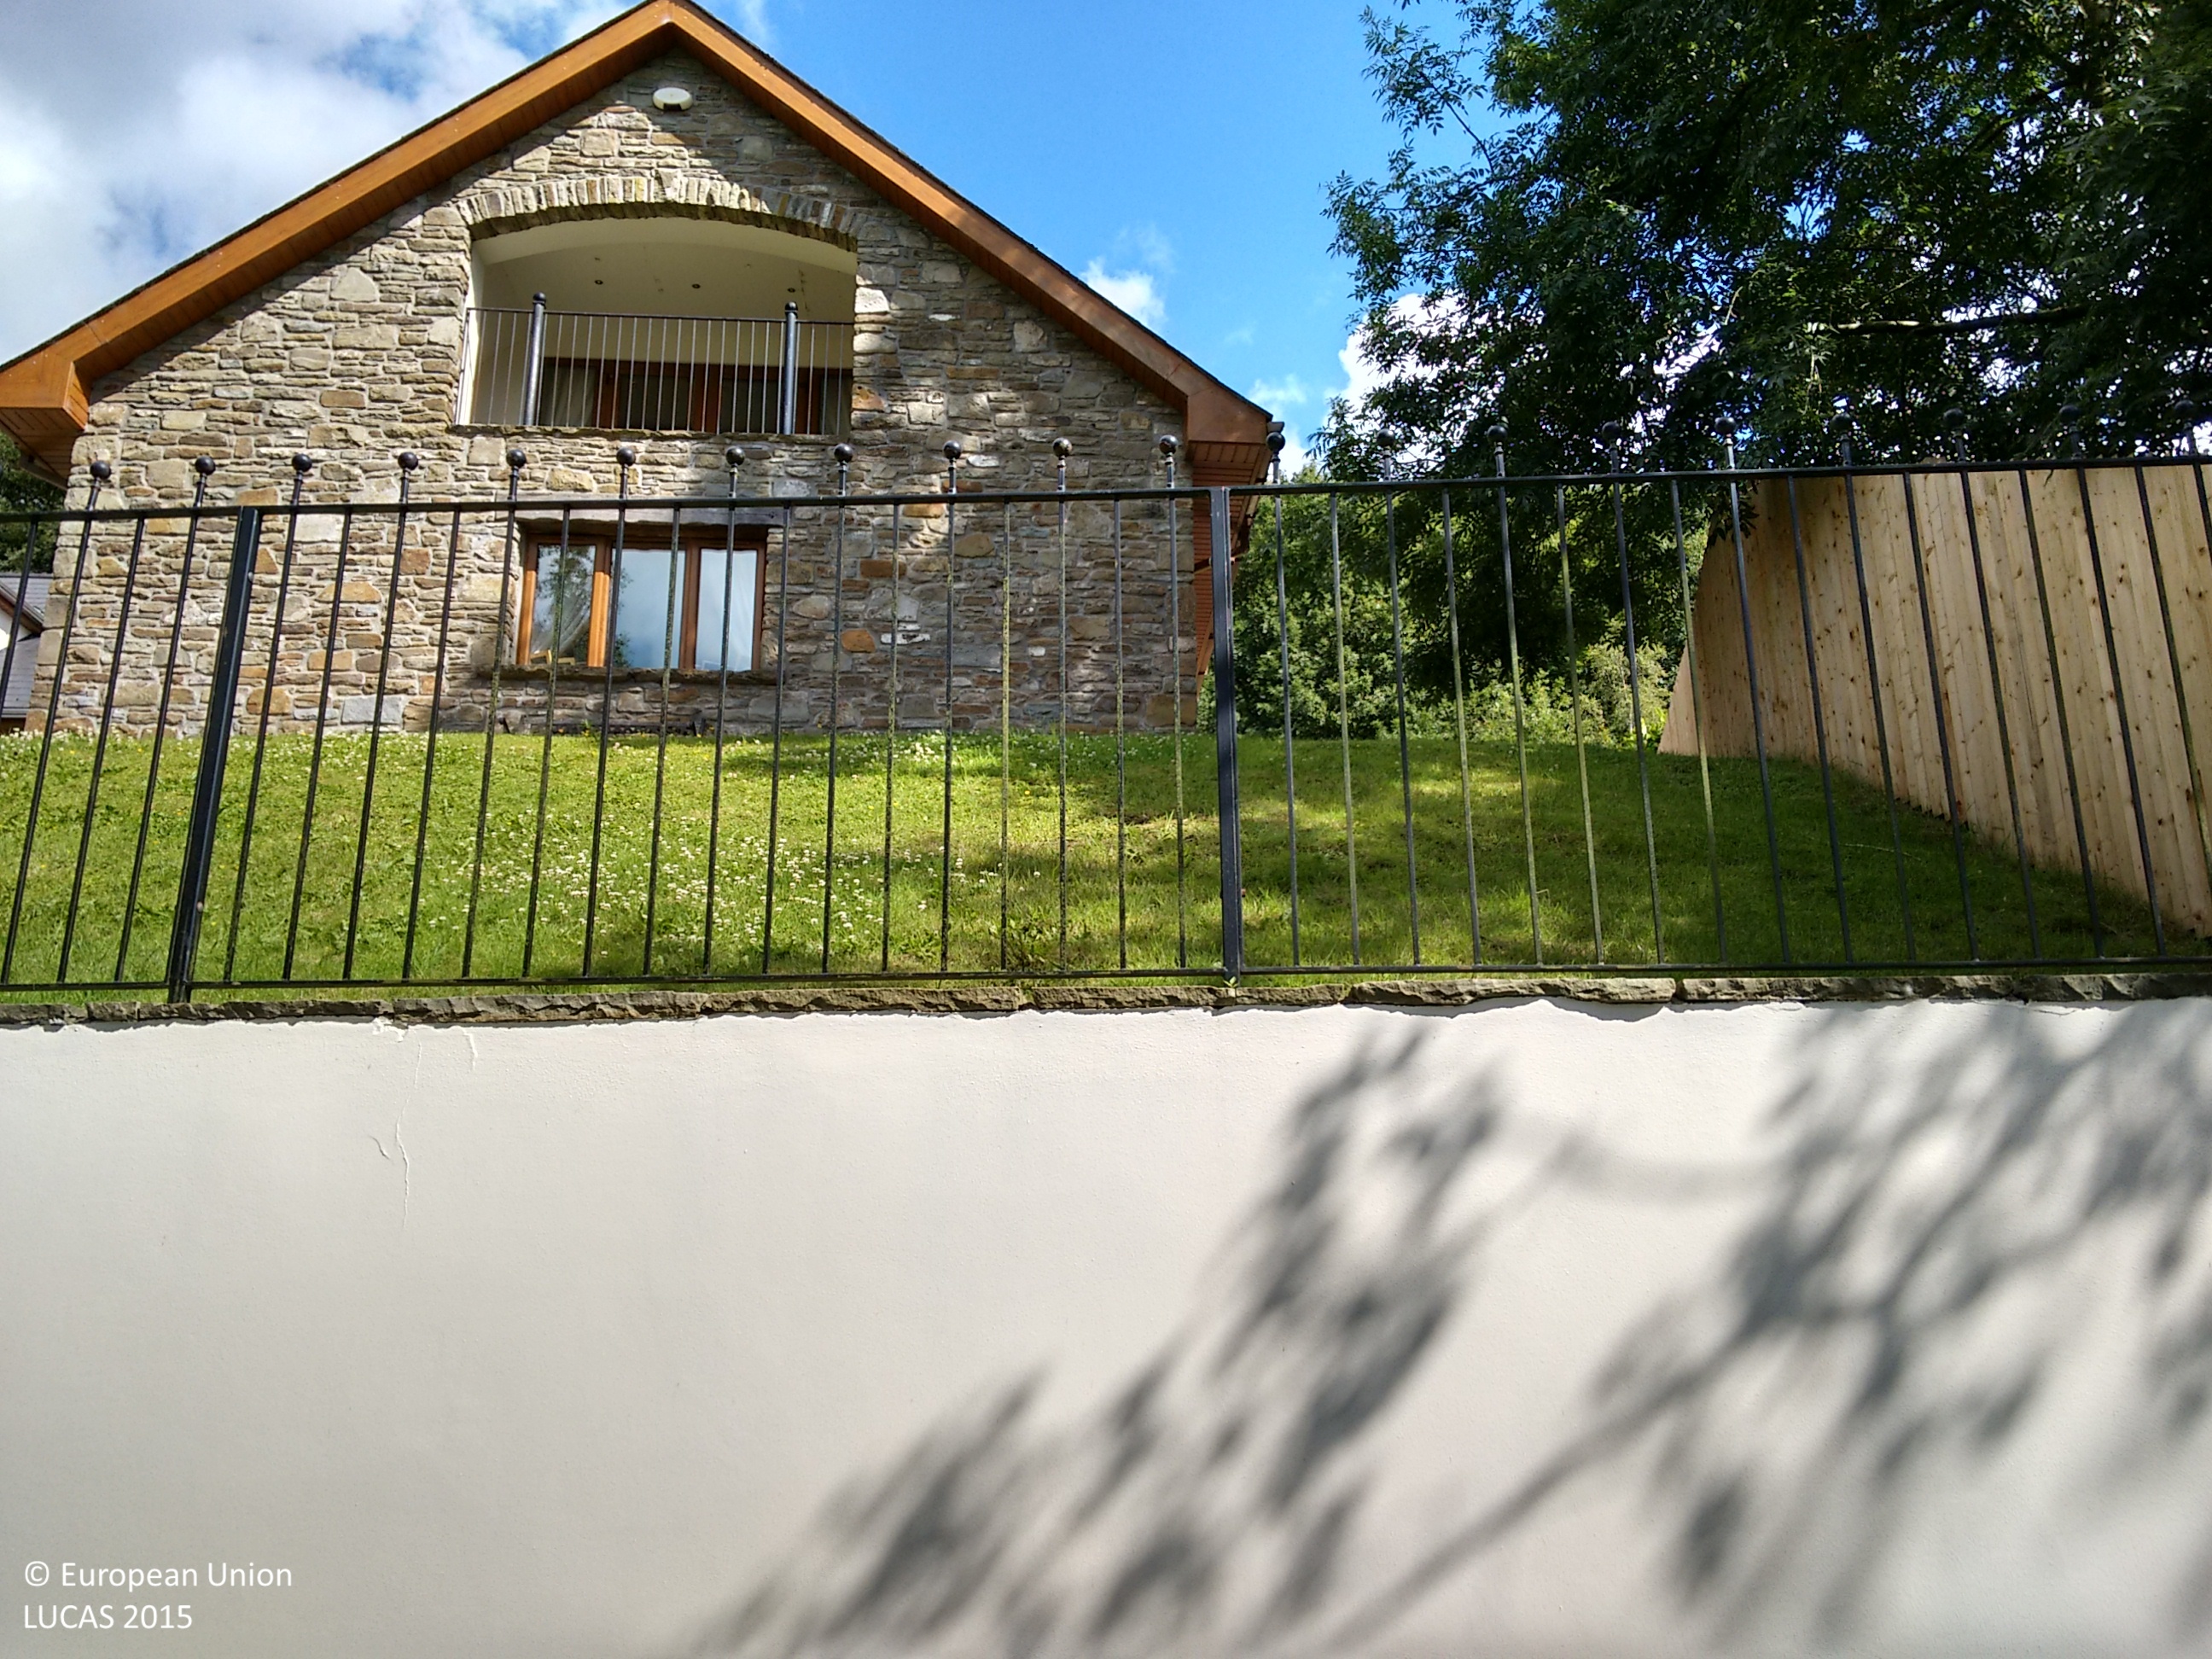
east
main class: Grassland
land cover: Grassland without tree/shrub cover
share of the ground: > 75 %
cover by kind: herbaceous plants 100 %
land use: Residential
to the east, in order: Grassland without tree/shrub cover; Artificial constructions in urban areas; Broadleaved woodland; Grassland without tree/shrub cover; Broadleaved woodland; Grassland with sparse tree/shrub cover
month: July
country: GB
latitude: 51.7358
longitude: -3.1244
